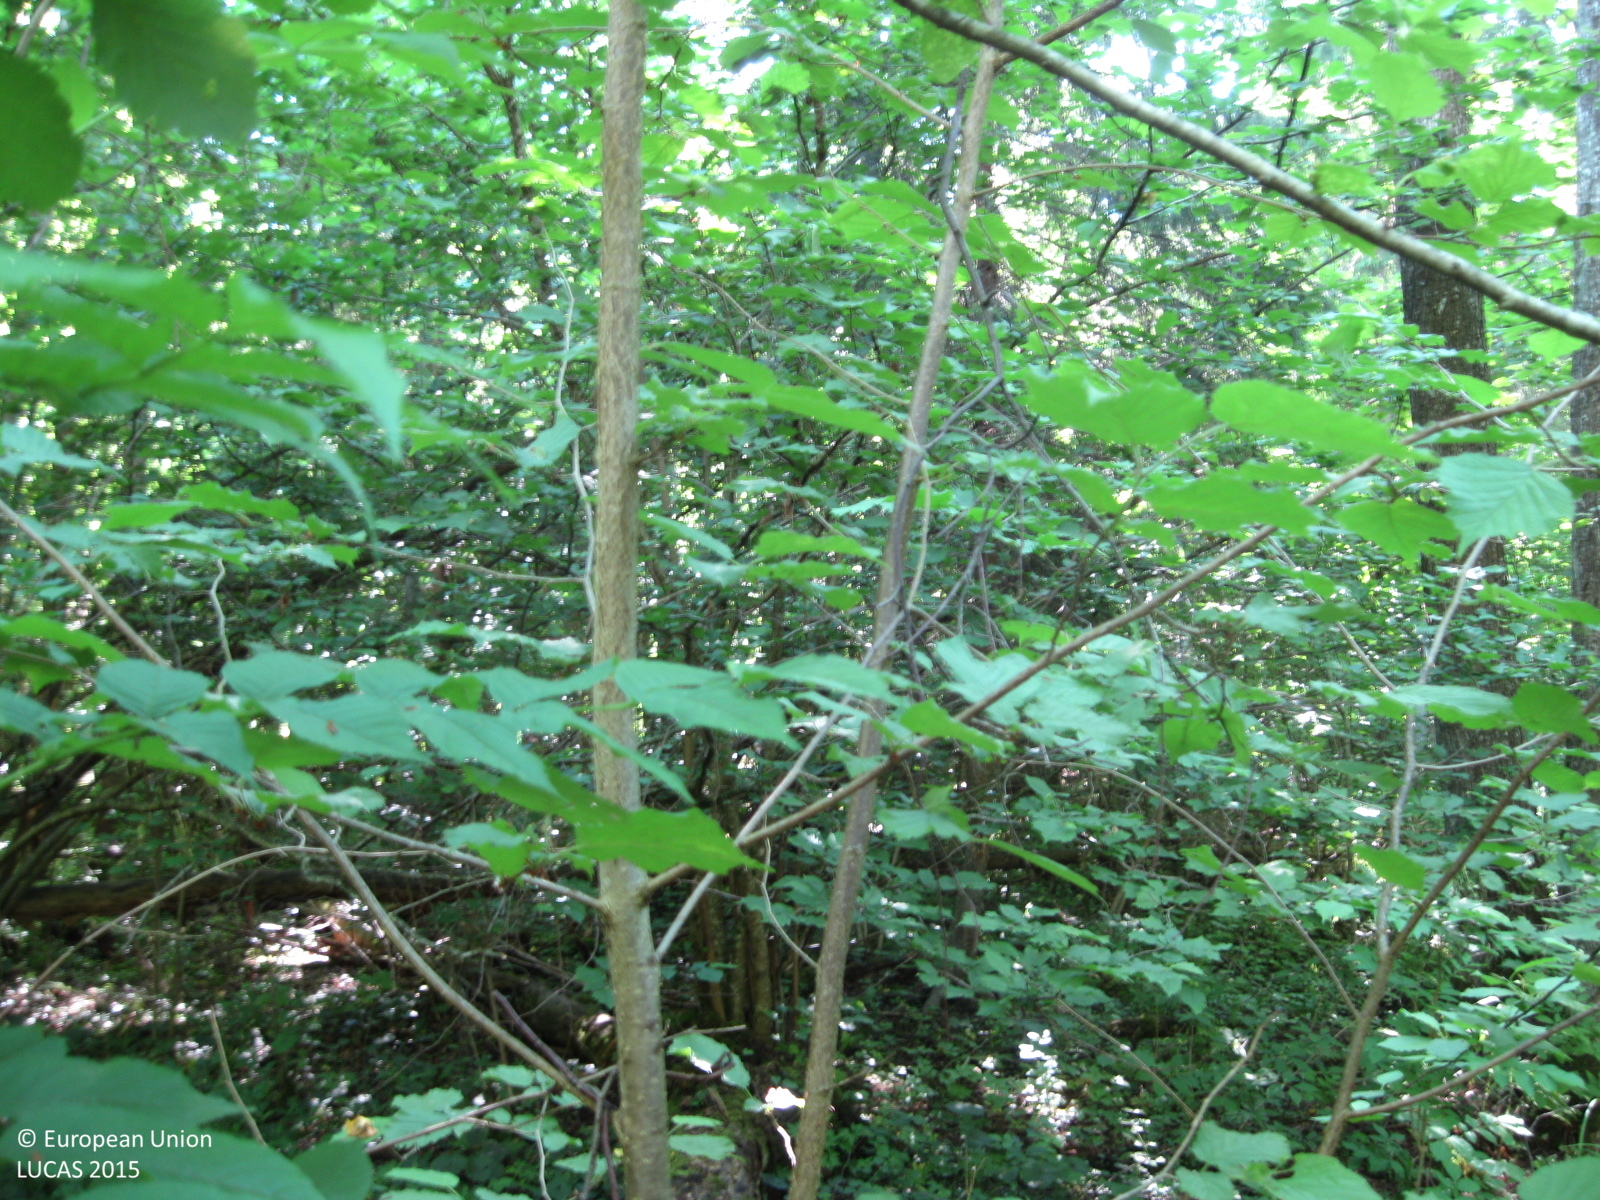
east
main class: Woodland
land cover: Spruce dominated mixed woodland
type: hemiboreal forest and nemoral coniferous forest and mixed broadleaved-coniferous forest
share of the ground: > 75 %
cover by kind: broadleaved forest trees 45 %, coniferous forest trees 35 %, herbaceous plants 20 %
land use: Forestry
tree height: > 5 m
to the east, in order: Spruce dominated mixed woodland; Broadleaved woodland; Shrubland with sparse tree cover; Broadleaved woodland
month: June
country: LT
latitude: 55.3295
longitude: 23.7829
